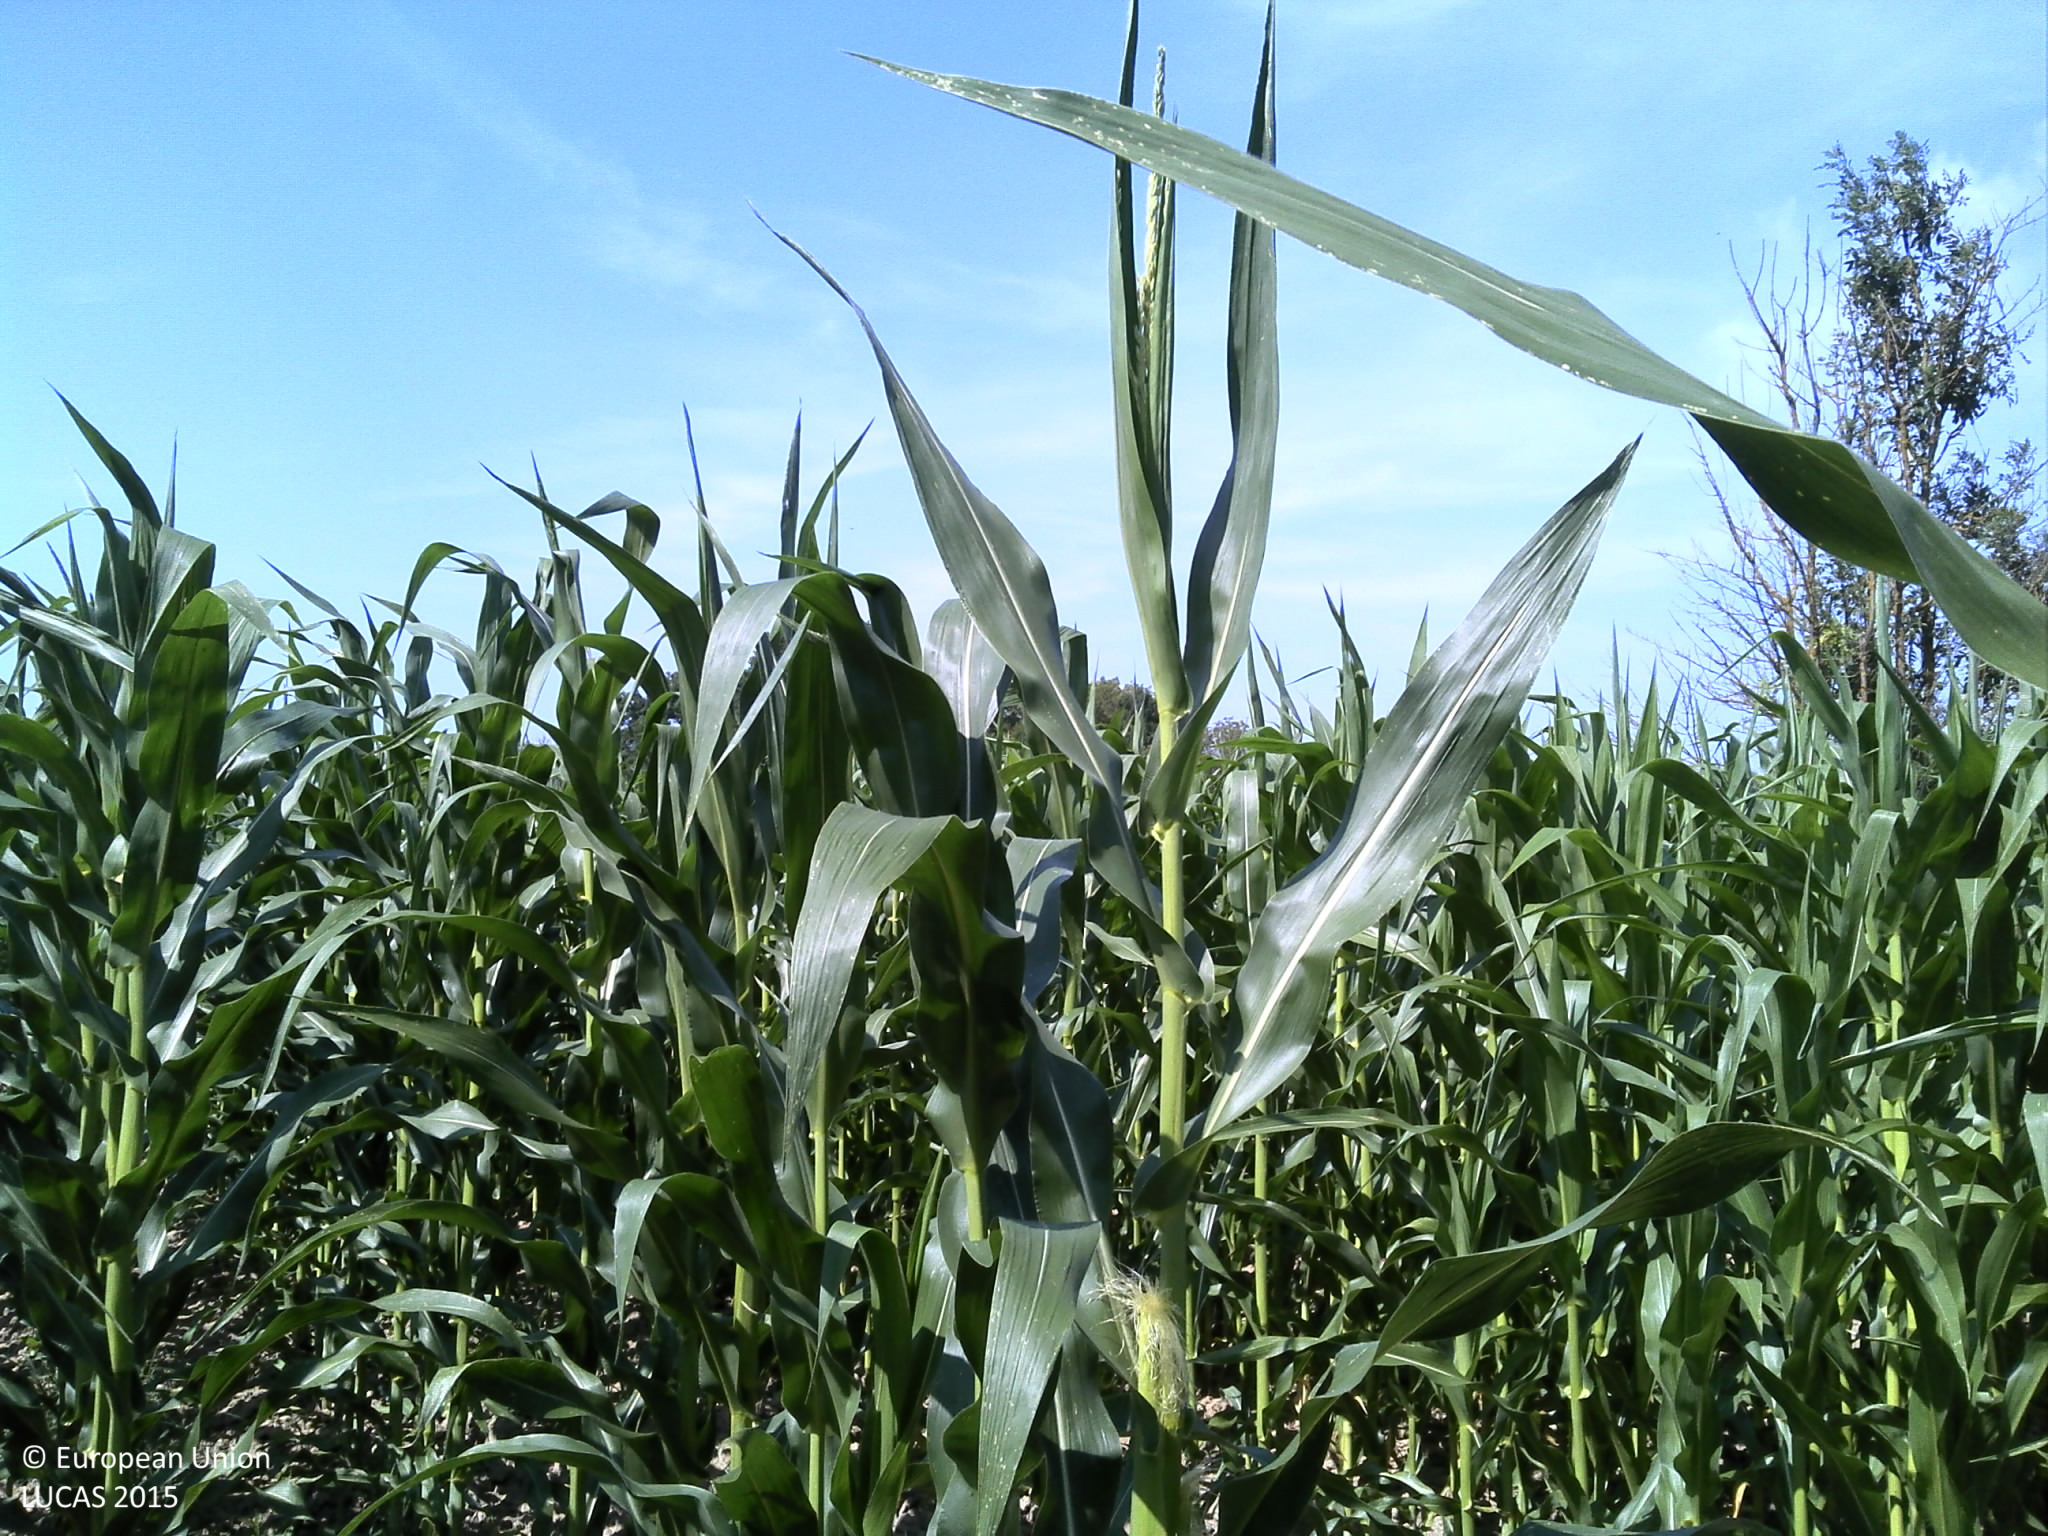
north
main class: Cropland
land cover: Maize
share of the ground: > 75 %
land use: Agriculture (excluding fallow land and kitchen gardens)
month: August
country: HR
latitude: 45.3849
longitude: 16.6522
